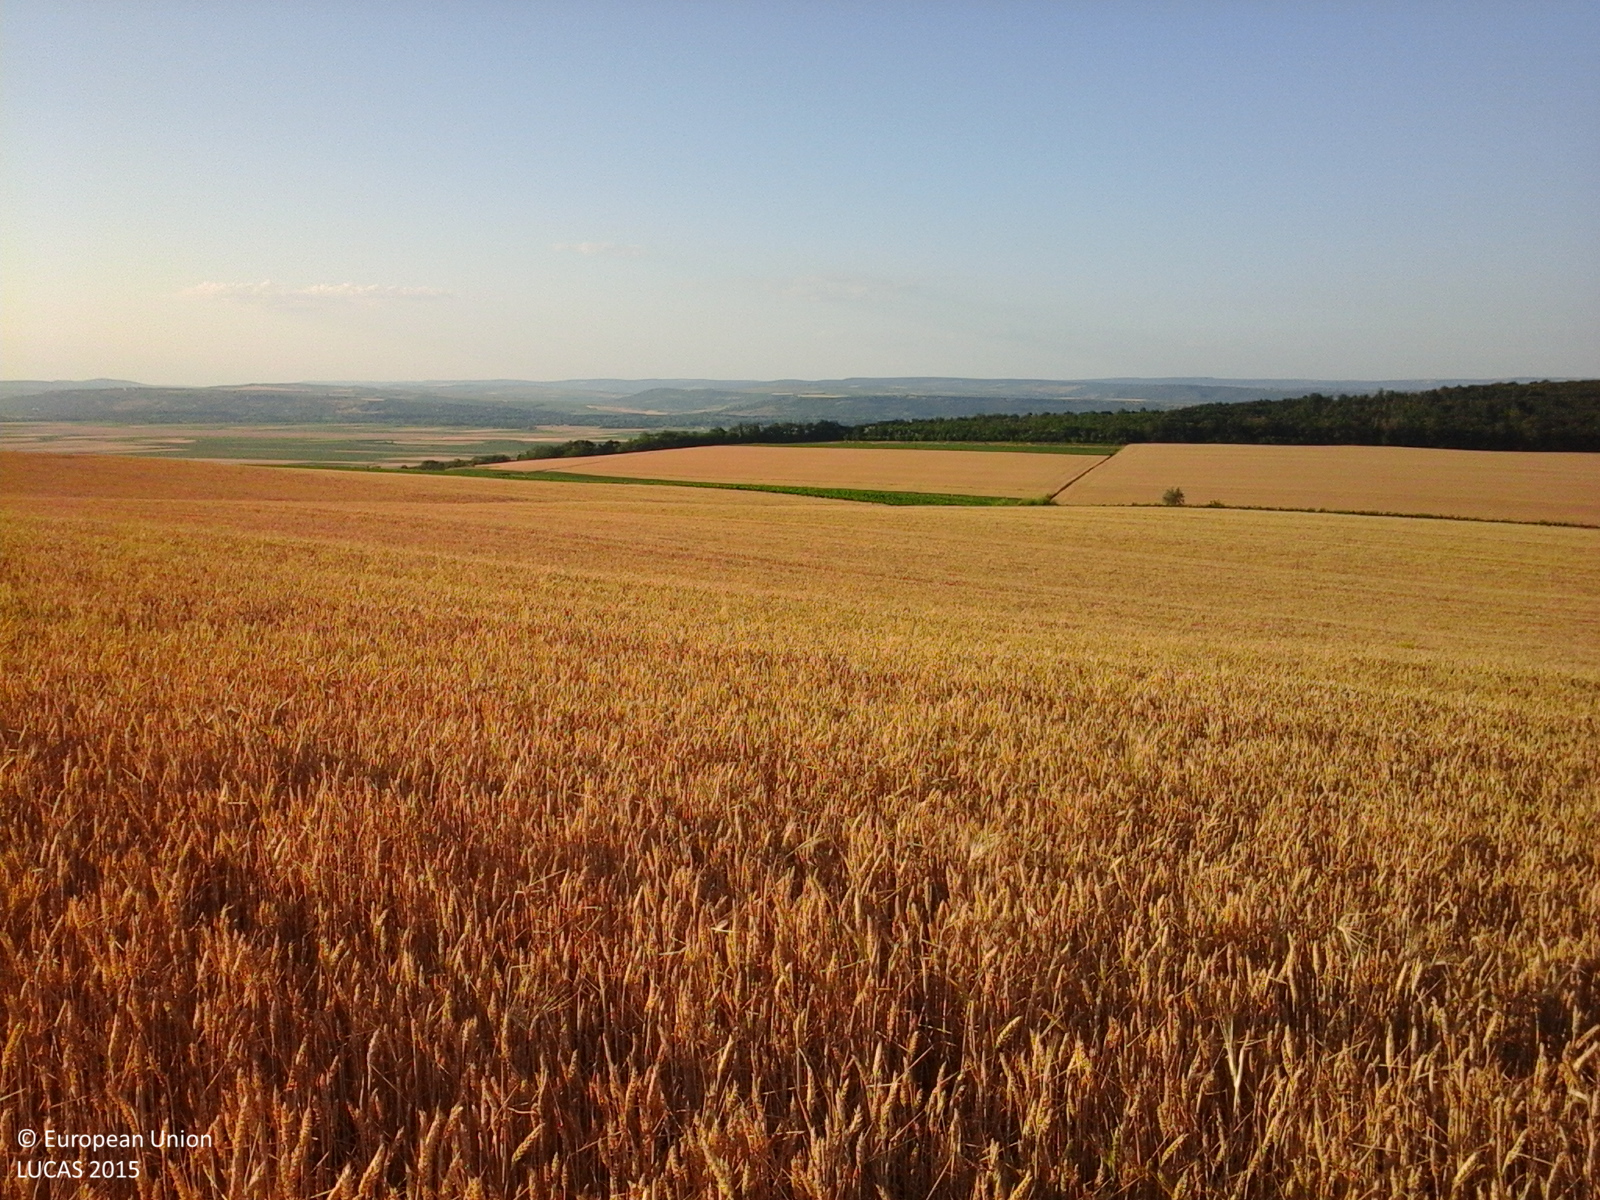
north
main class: Cropland
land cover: Common wheat
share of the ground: > 75 %
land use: Agriculture (excluding fallow land and kitchen gardens)
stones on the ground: < 10 %
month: June
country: RO
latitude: 46.9664
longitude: 27.9911
